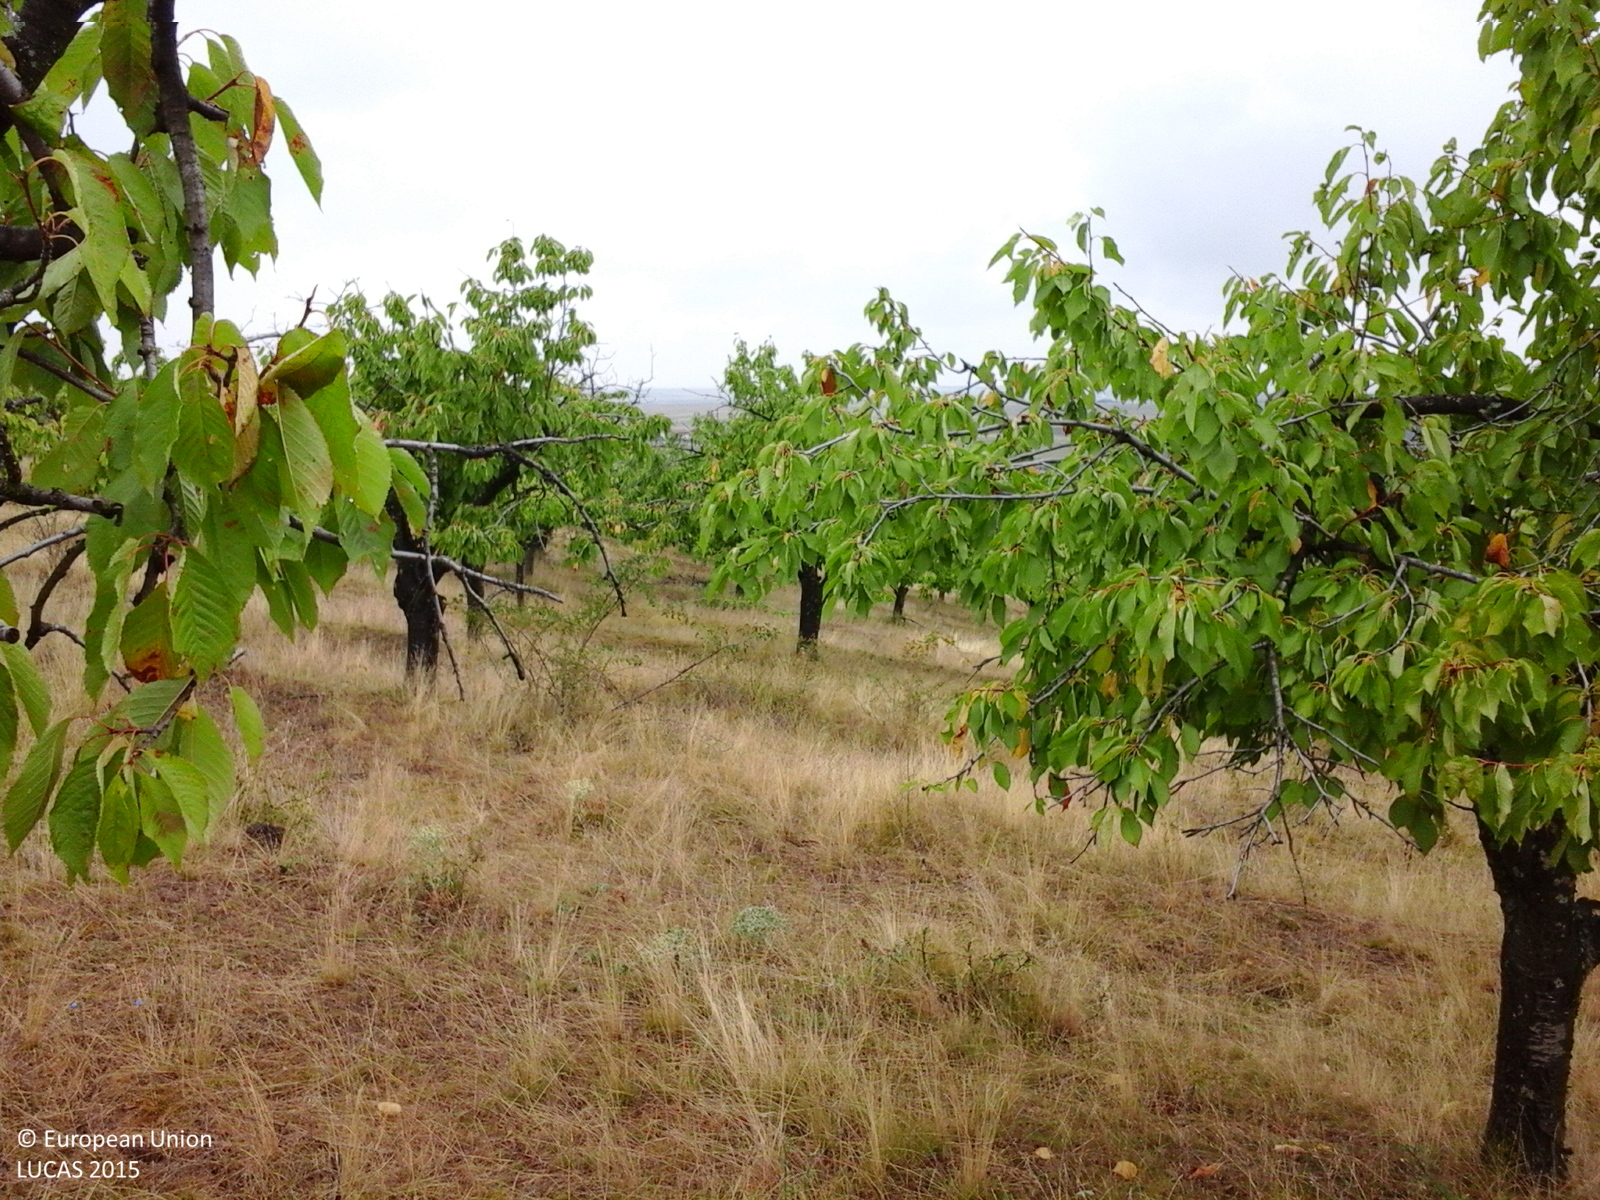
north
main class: Cropland
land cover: Cherry fruit
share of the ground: 50 - 75 %
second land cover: Grassland without tree/shrub cover
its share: > 75 %
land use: Agriculture (excluding fallow land and kitchen gardens)
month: August
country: RO
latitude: 45.9016
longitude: 21.4151
